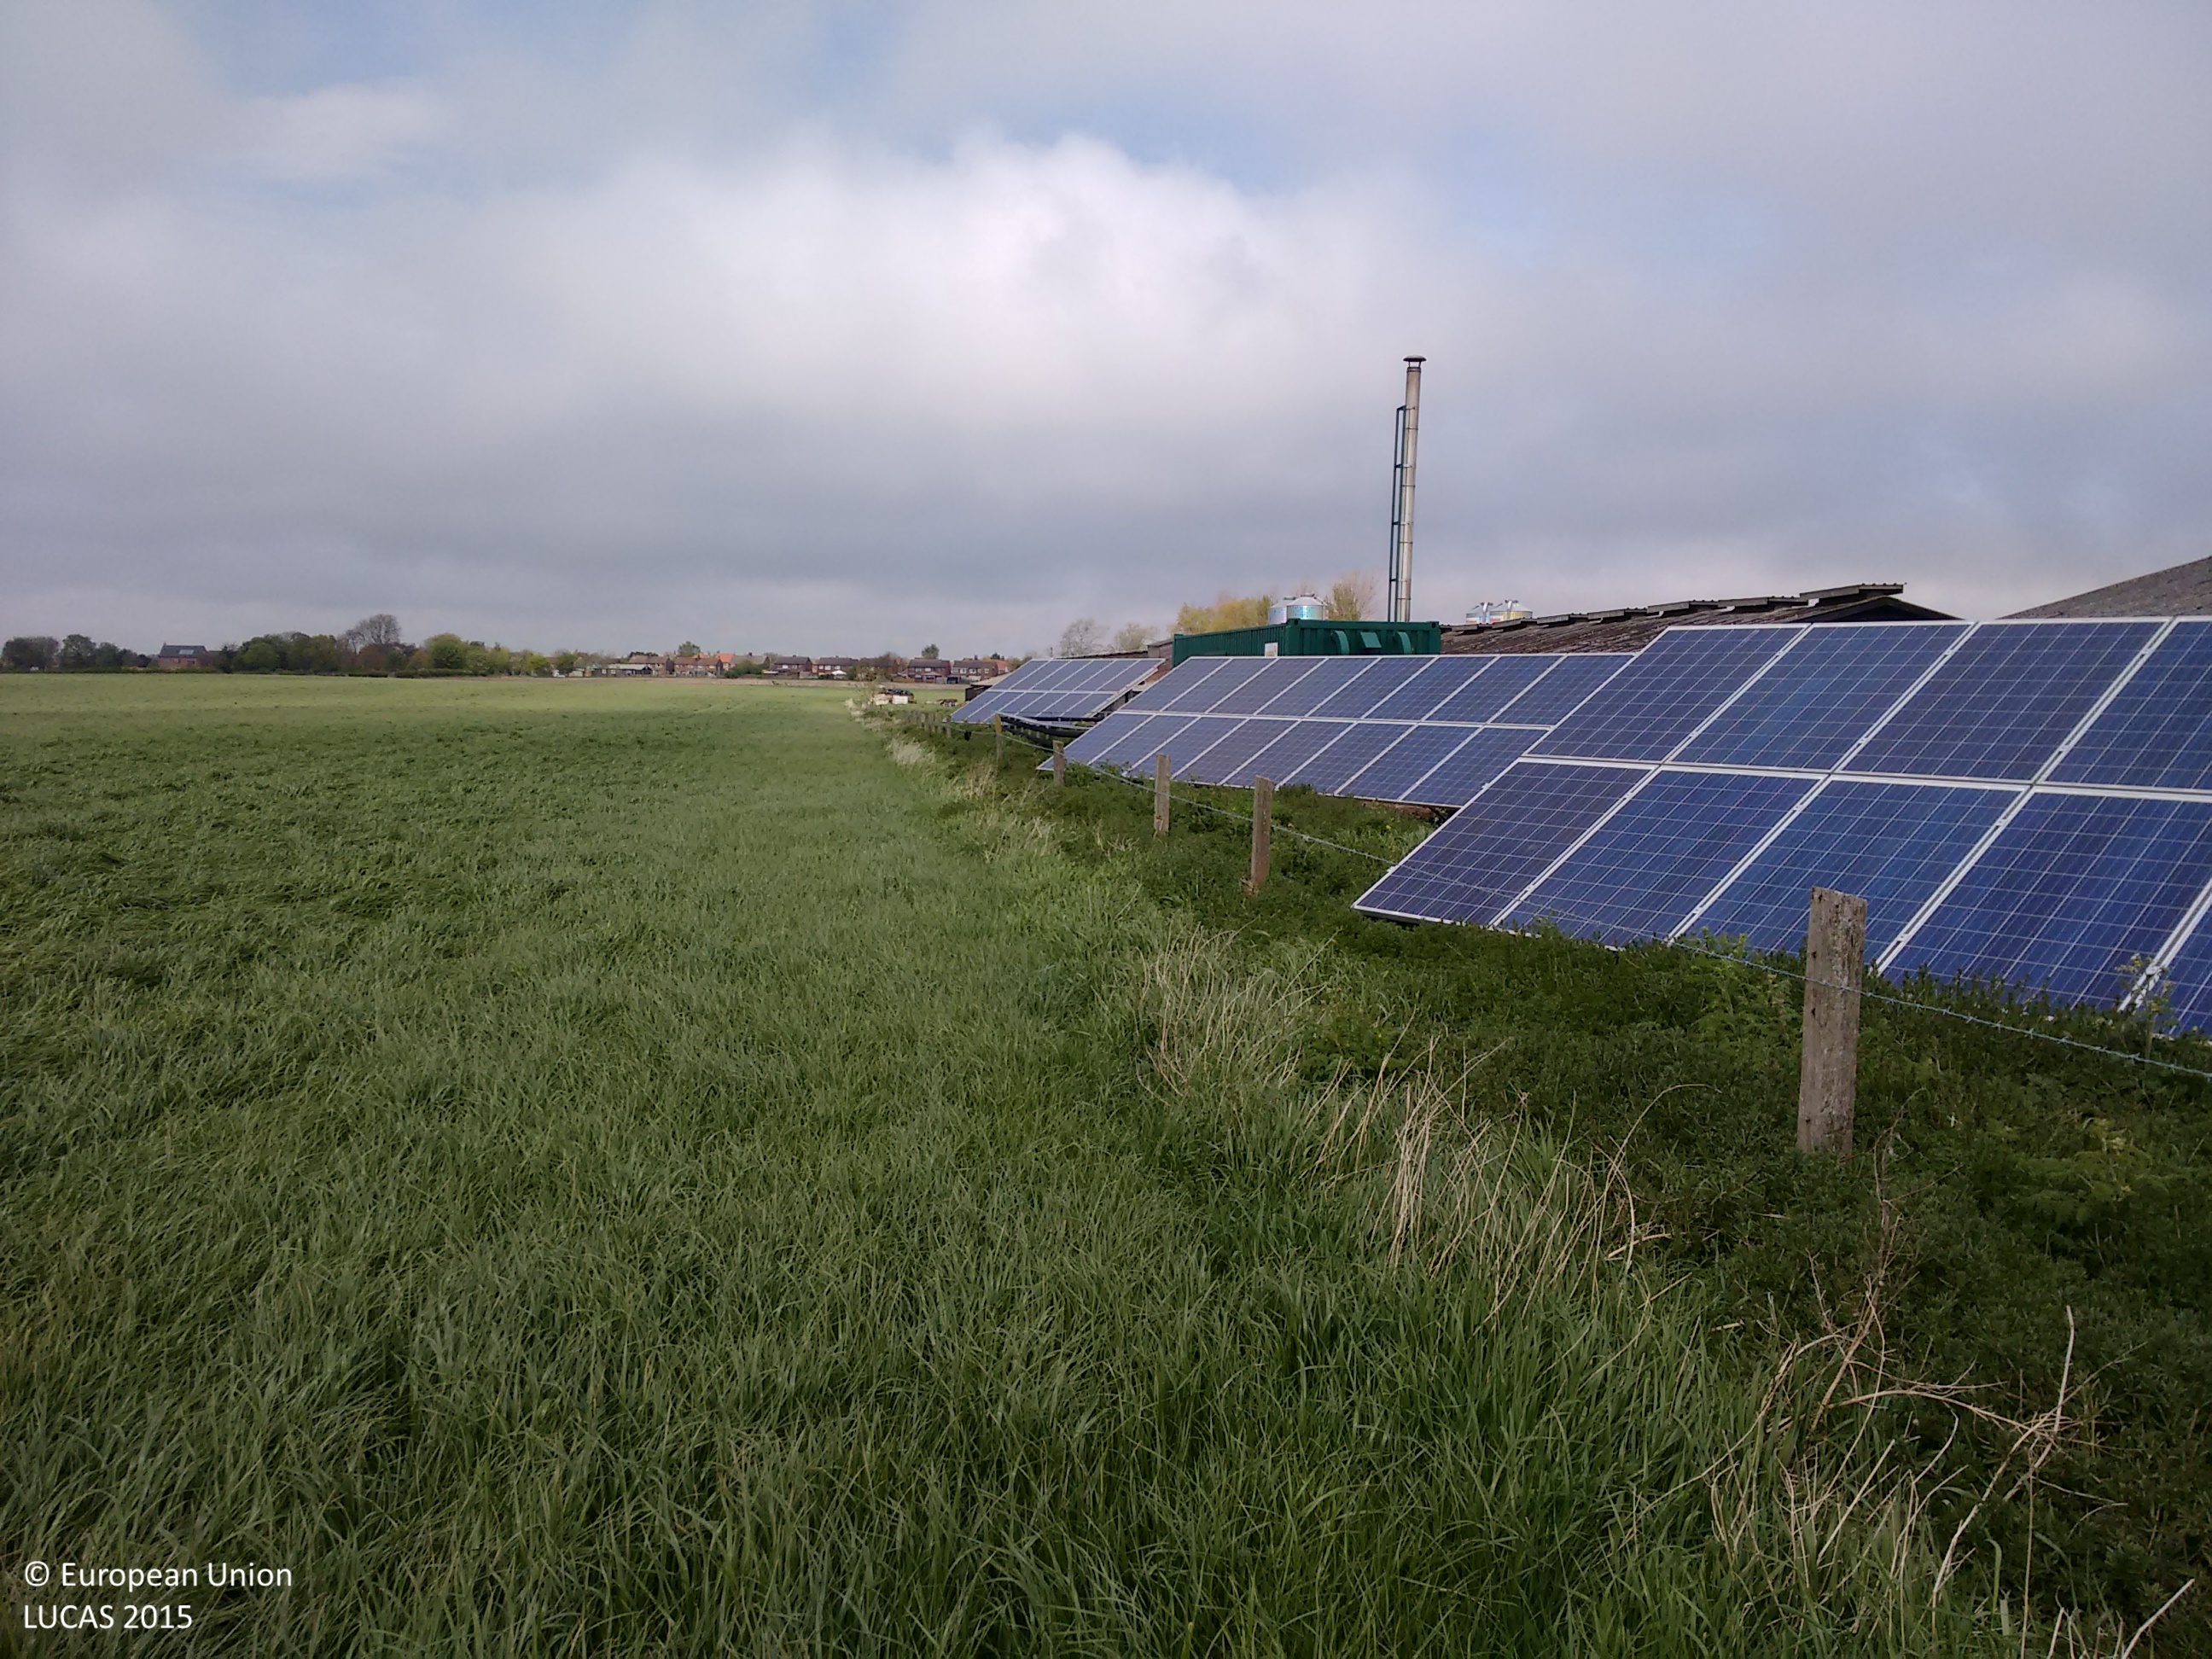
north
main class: Grassland
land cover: Grassland without tree/shrub cover
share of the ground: > 75 %
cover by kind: herbaceous plants 100 %
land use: Agriculture (excluding fallow land and kitchen gardens)
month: May
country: GB
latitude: 53.9569
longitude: -0.3215
